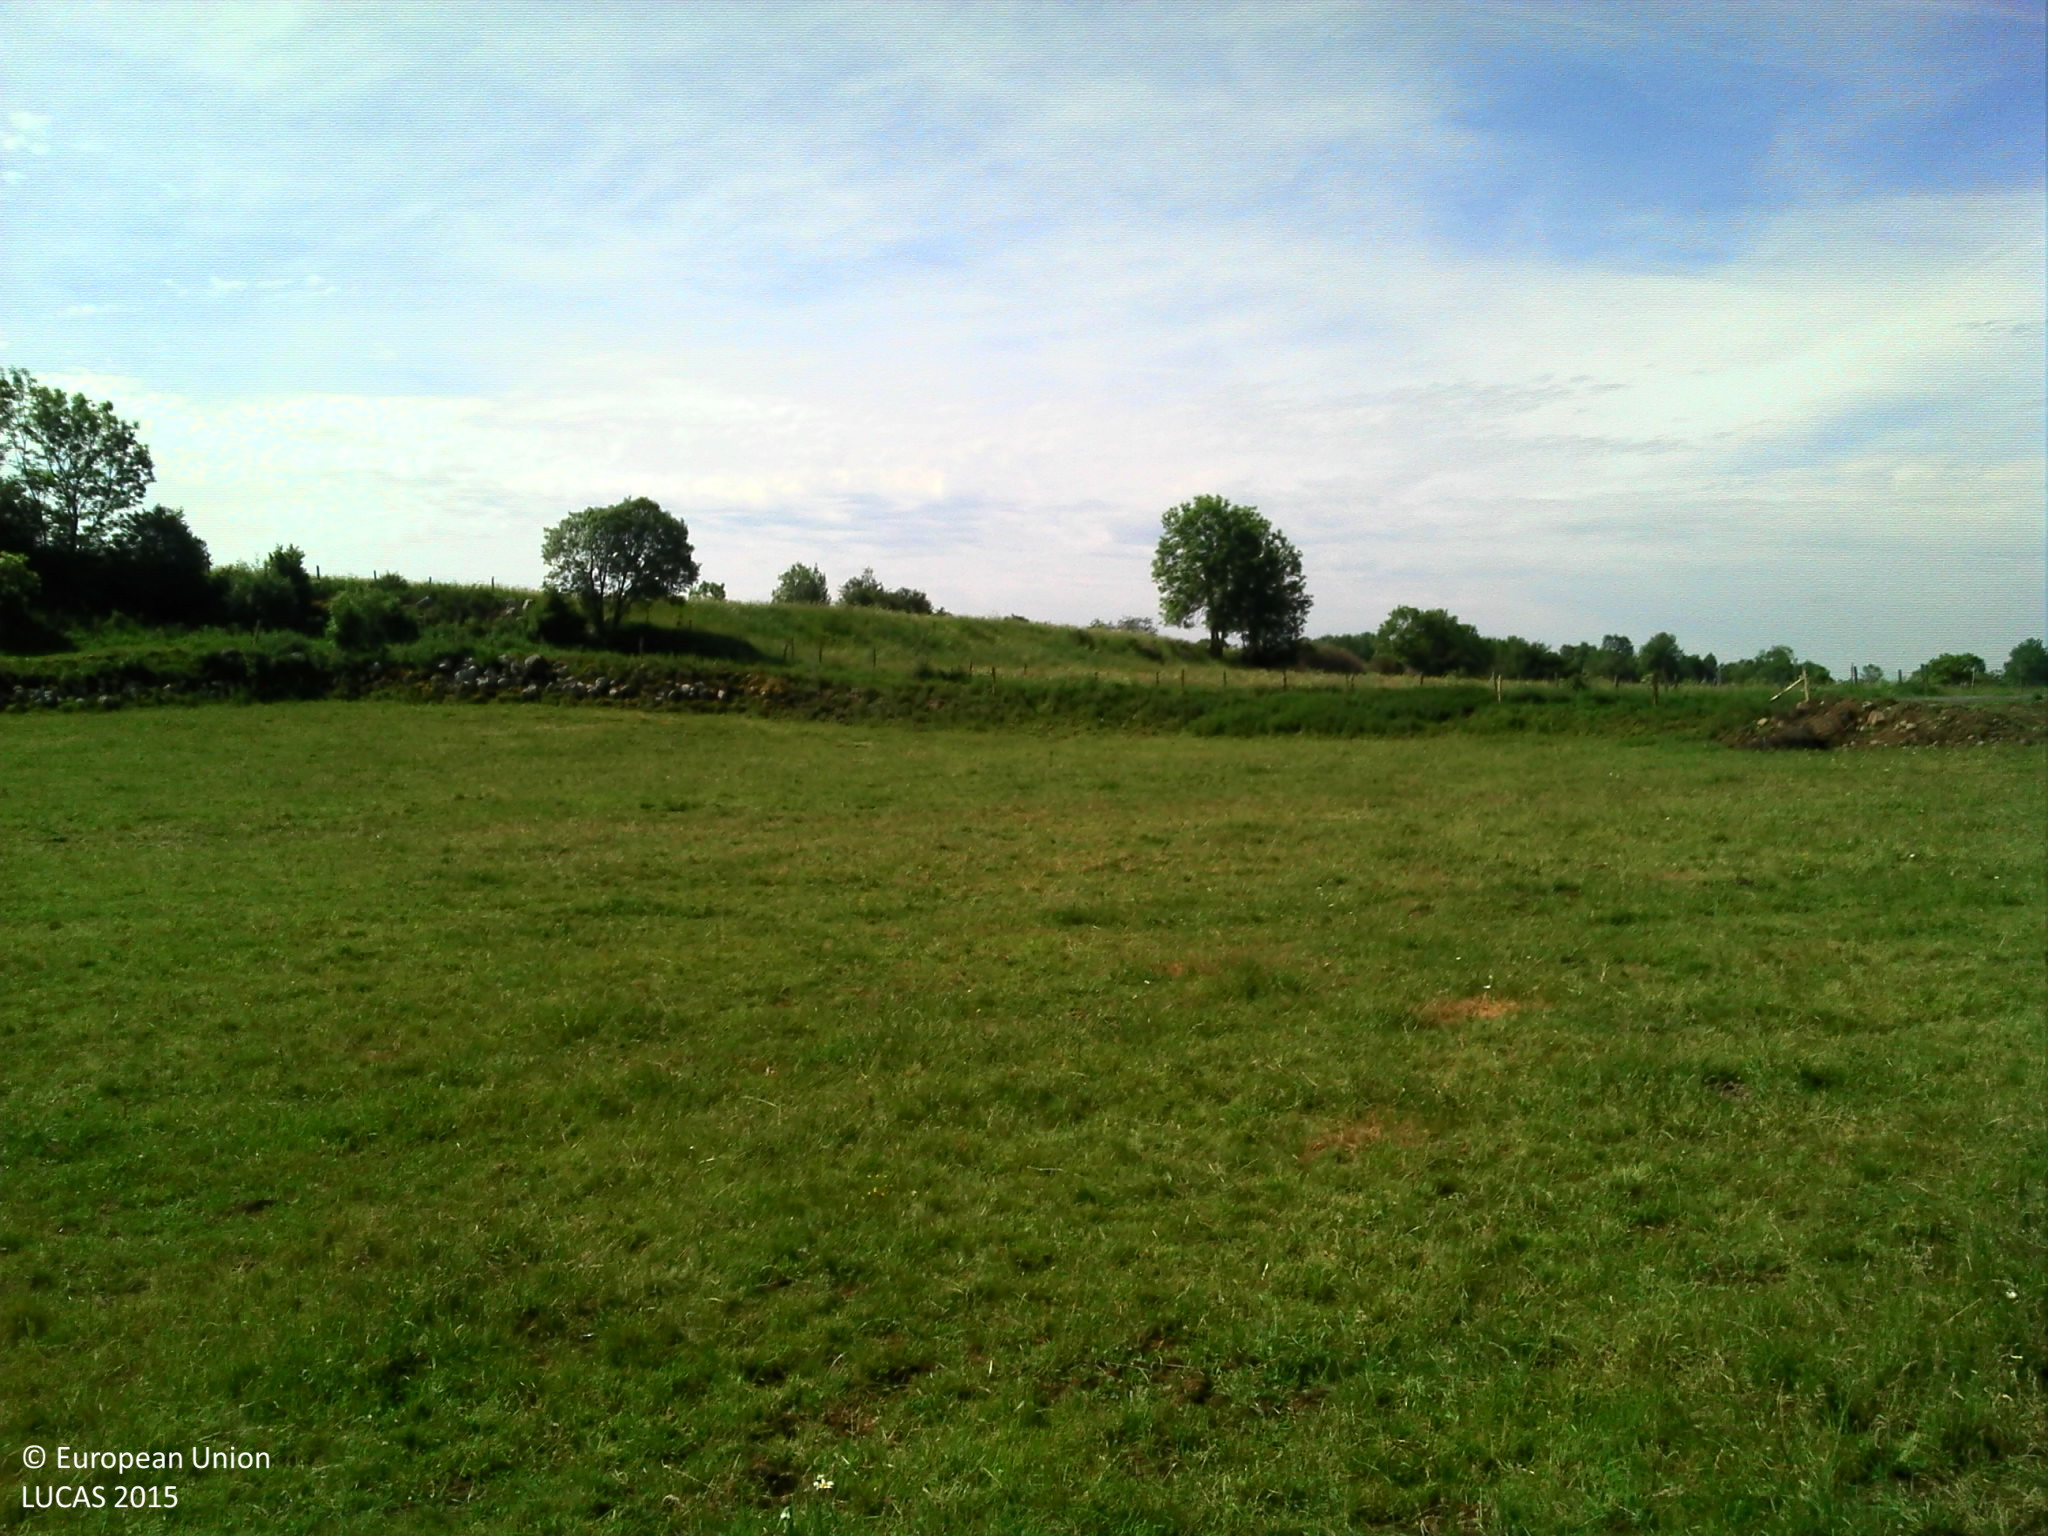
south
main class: Grassland
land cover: Grassland without tree/shrub cover
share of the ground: > 75 %
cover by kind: herbaceous plants 100 %
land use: Agriculture (excluding fallow land and kitchen gardens)
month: June
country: FR
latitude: 45.1398
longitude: 2.9181
